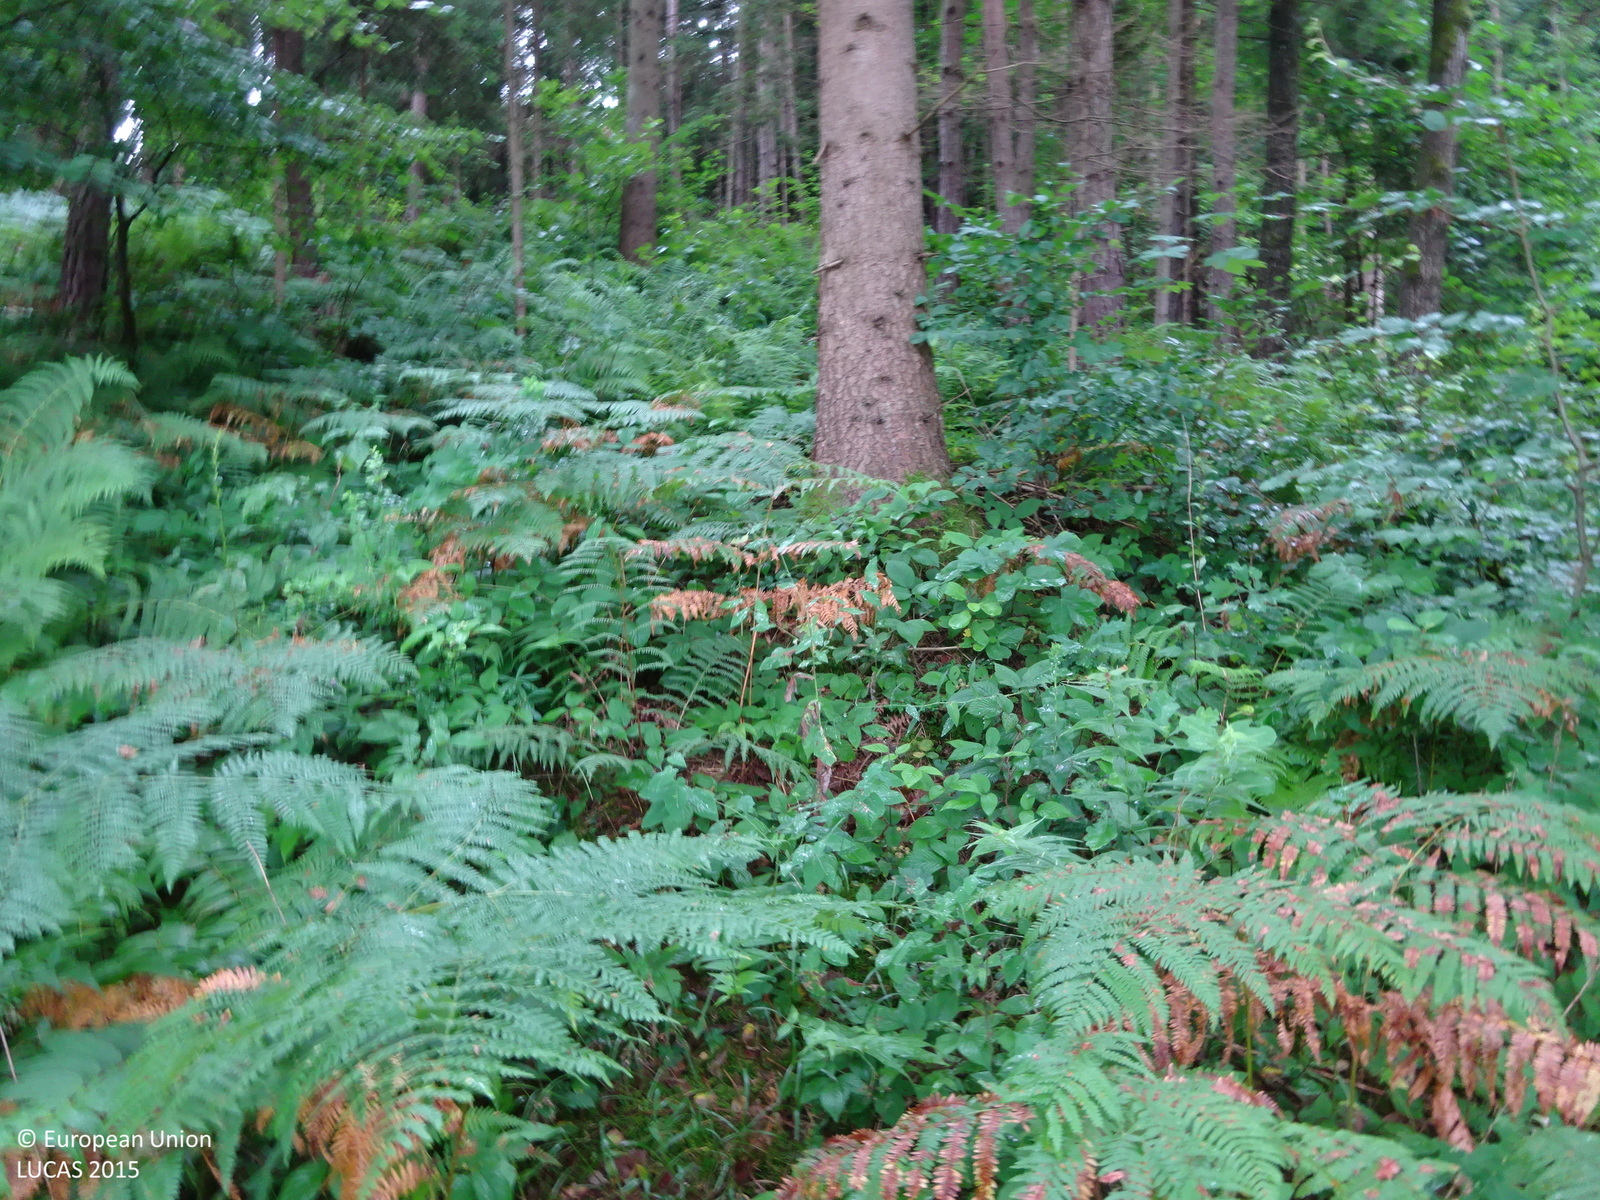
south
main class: Woodland
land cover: Spruce dominated coniferous woodland
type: alpine coniferous forest
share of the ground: > 75 %
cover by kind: coniferous forest trees 90 %, shrubs 5 %, herbaceous plants 5 %
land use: Forestry
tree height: > 5 m
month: July
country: AT
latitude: 46.7932
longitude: 15.3835
